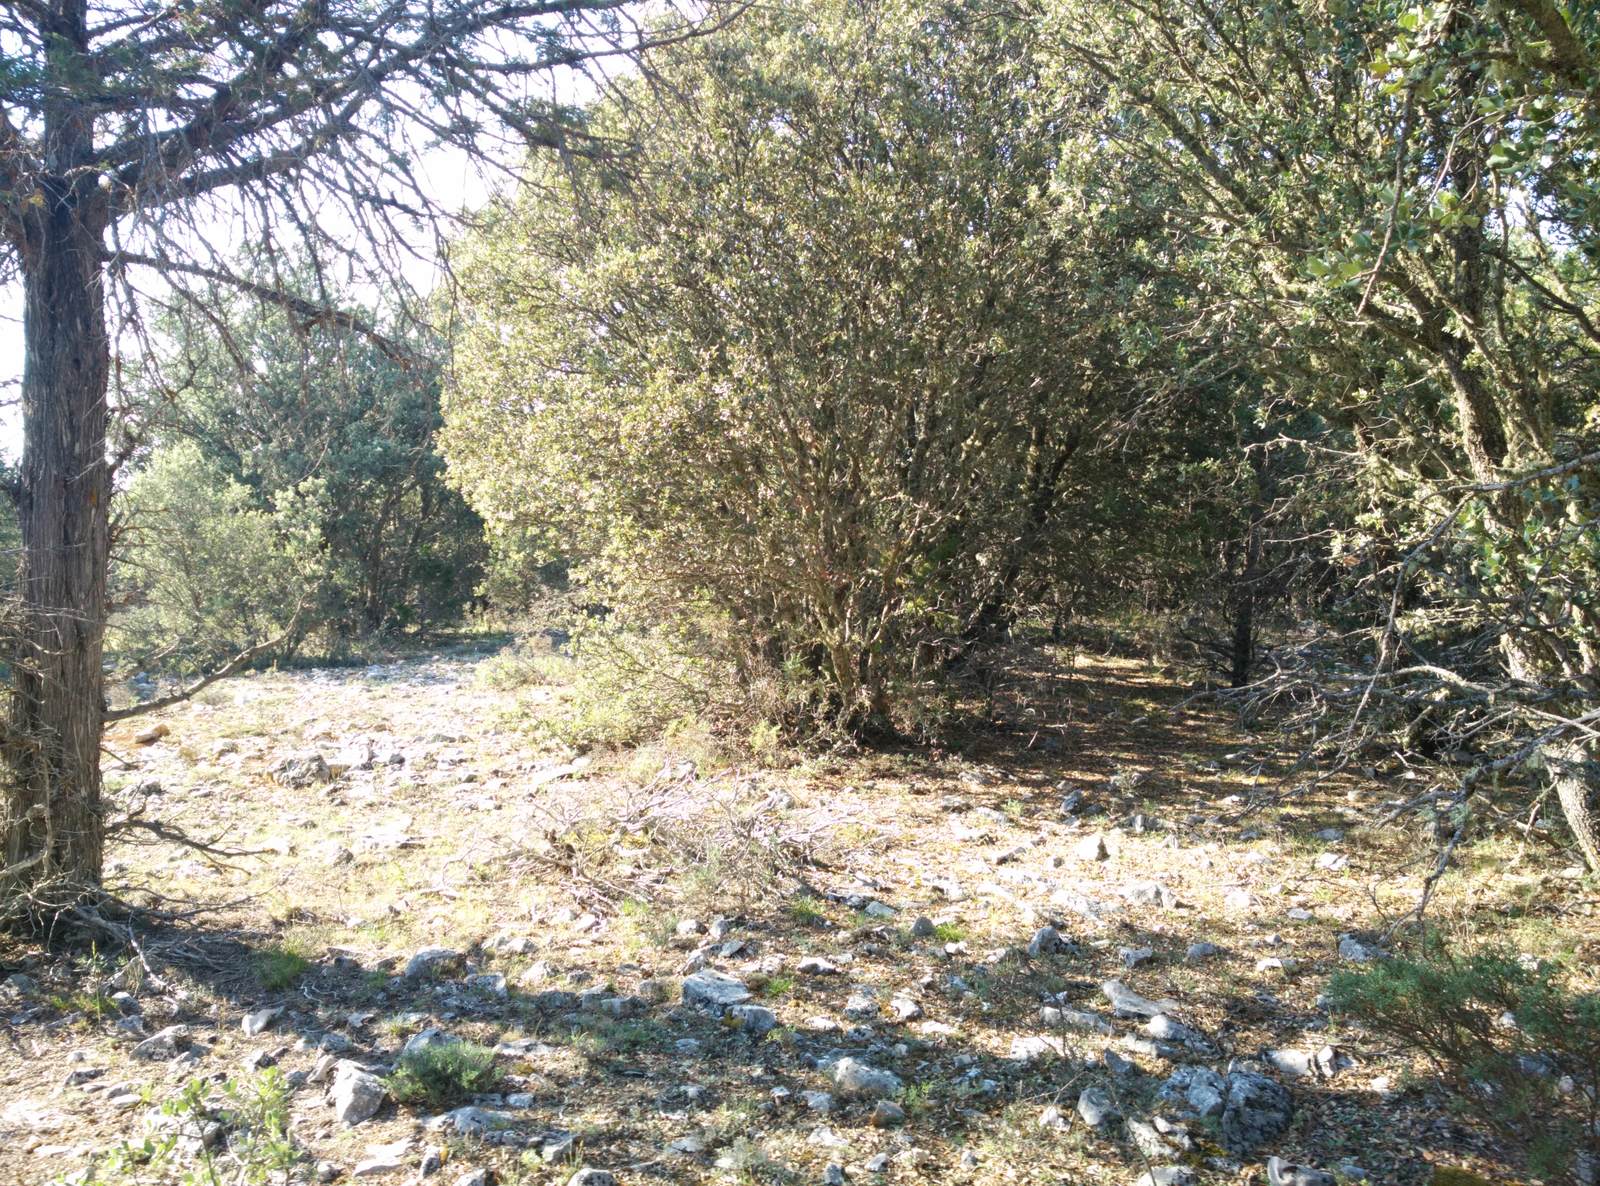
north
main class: Woodland
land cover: Broadleaved woodland
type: broadleaved evergreen forest
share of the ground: 50 - 75 %
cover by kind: broadleaved forest trees 65 %, unconsolidated bare surface 25 %, shrubs 5 %, herbaceous plants 5 %
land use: Semi-natural and natural areas not in use
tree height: > 5 m
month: June
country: ES
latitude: 40.7184
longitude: -1.8230
